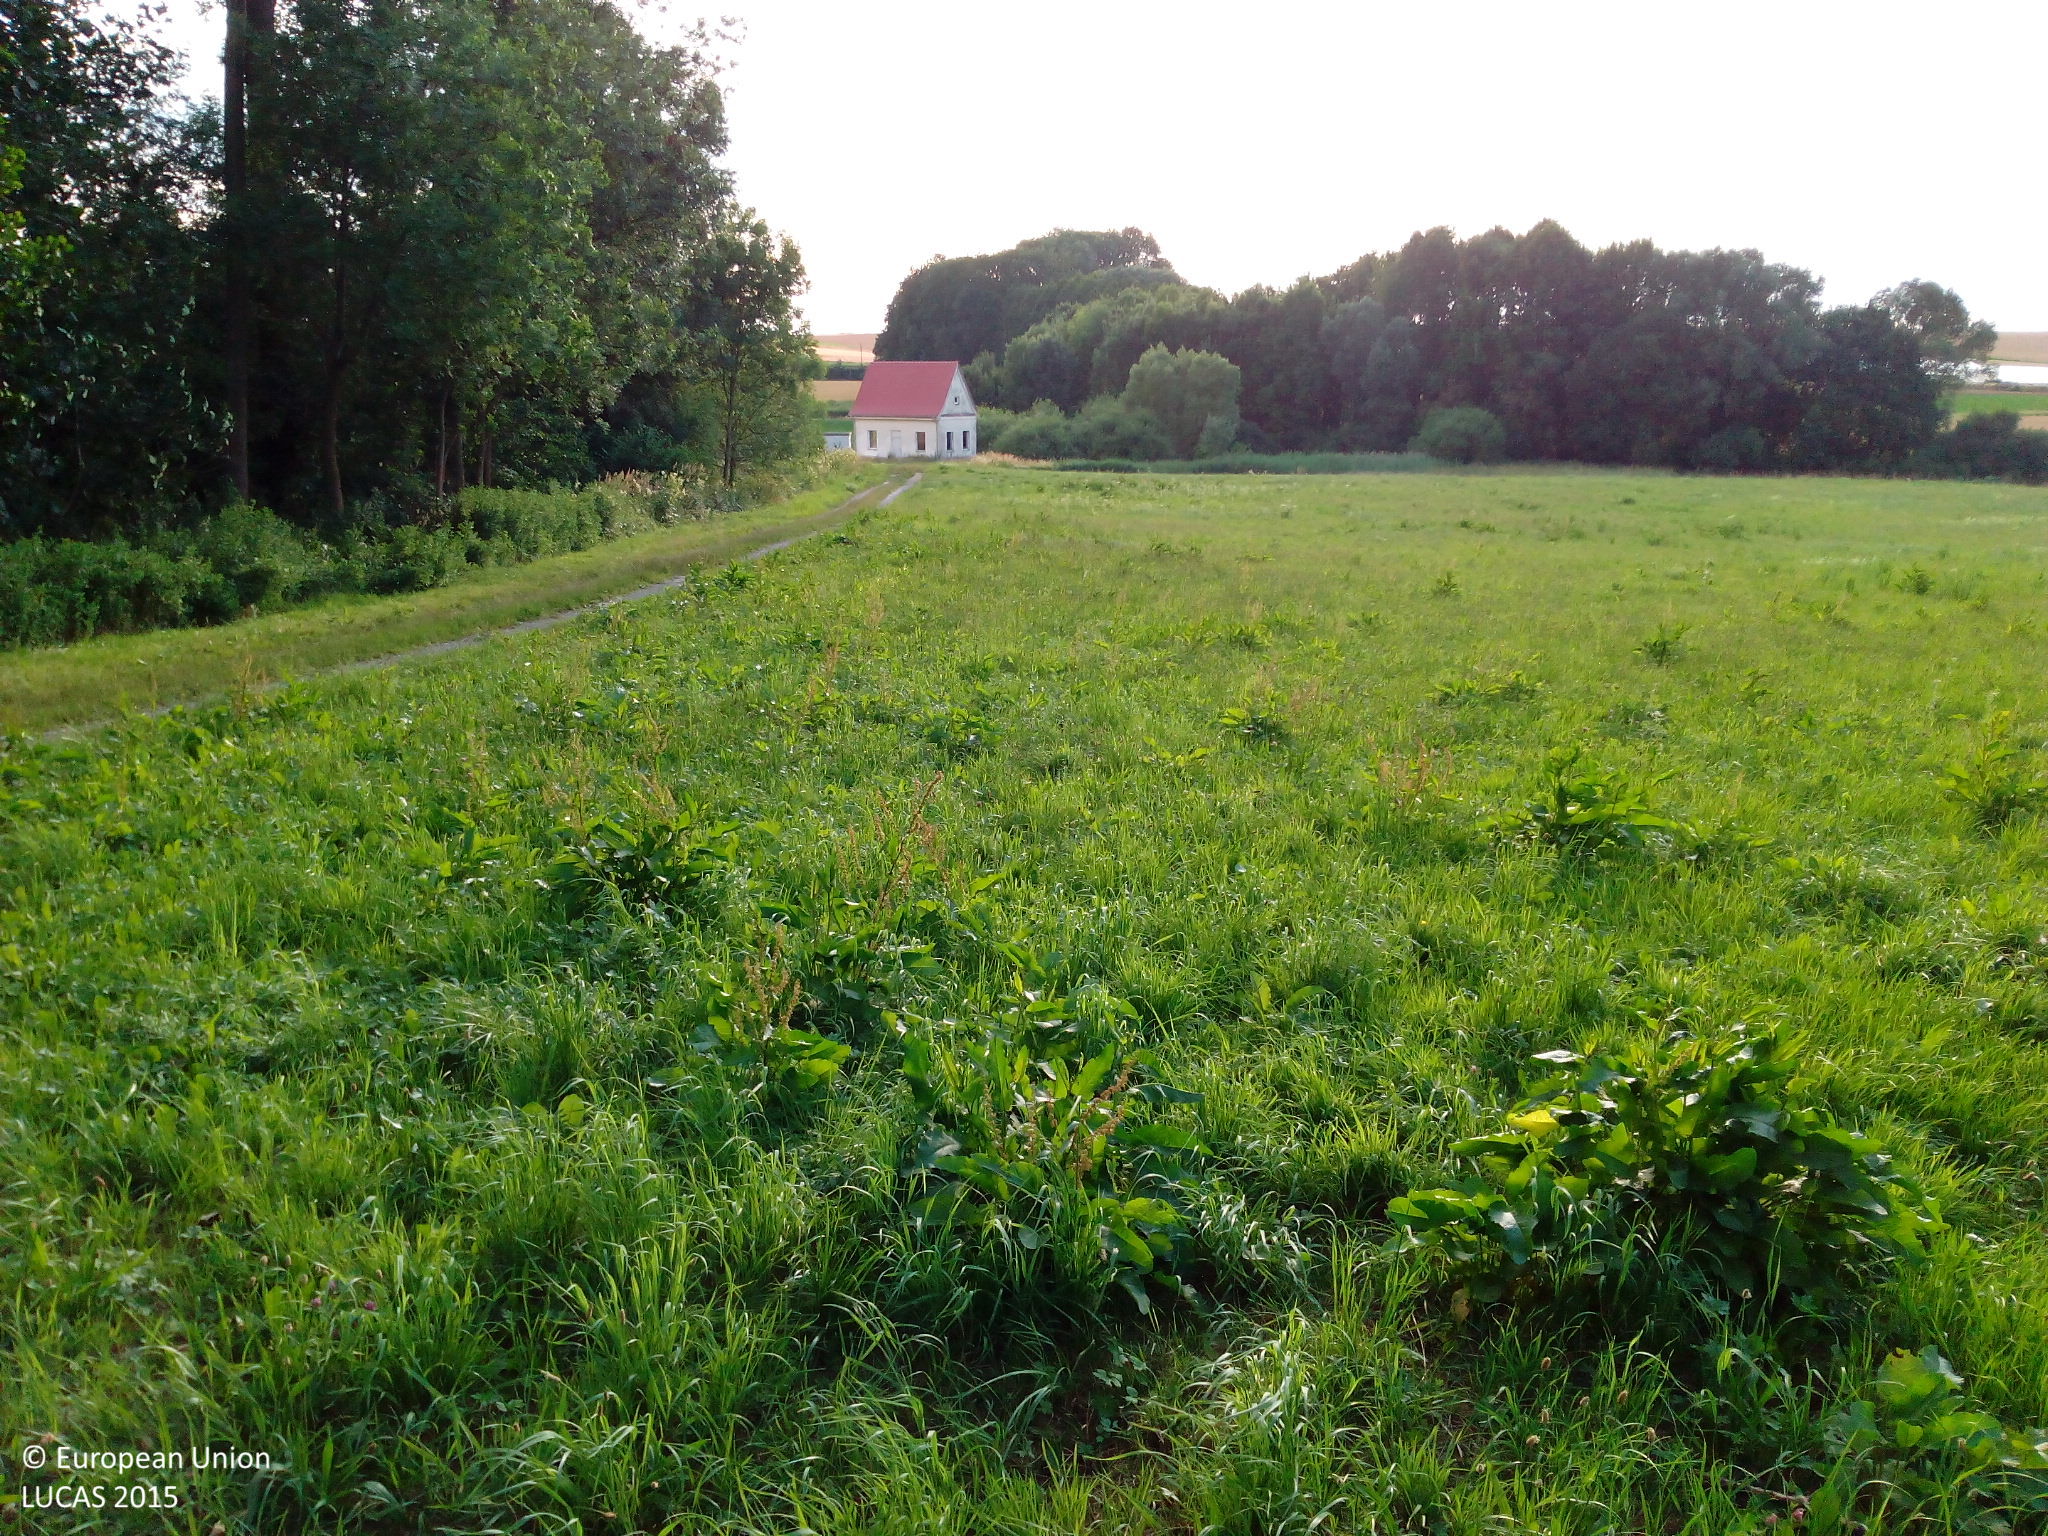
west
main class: Grassland
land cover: Grassland without tree/shrub cover
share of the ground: > 75 %
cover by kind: herbaceous plants 100 %
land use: Agriculture (excluding fallow land and kitchen gardens)
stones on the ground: < 10 %
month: July
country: DE
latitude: 49.6987
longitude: 9.9307
